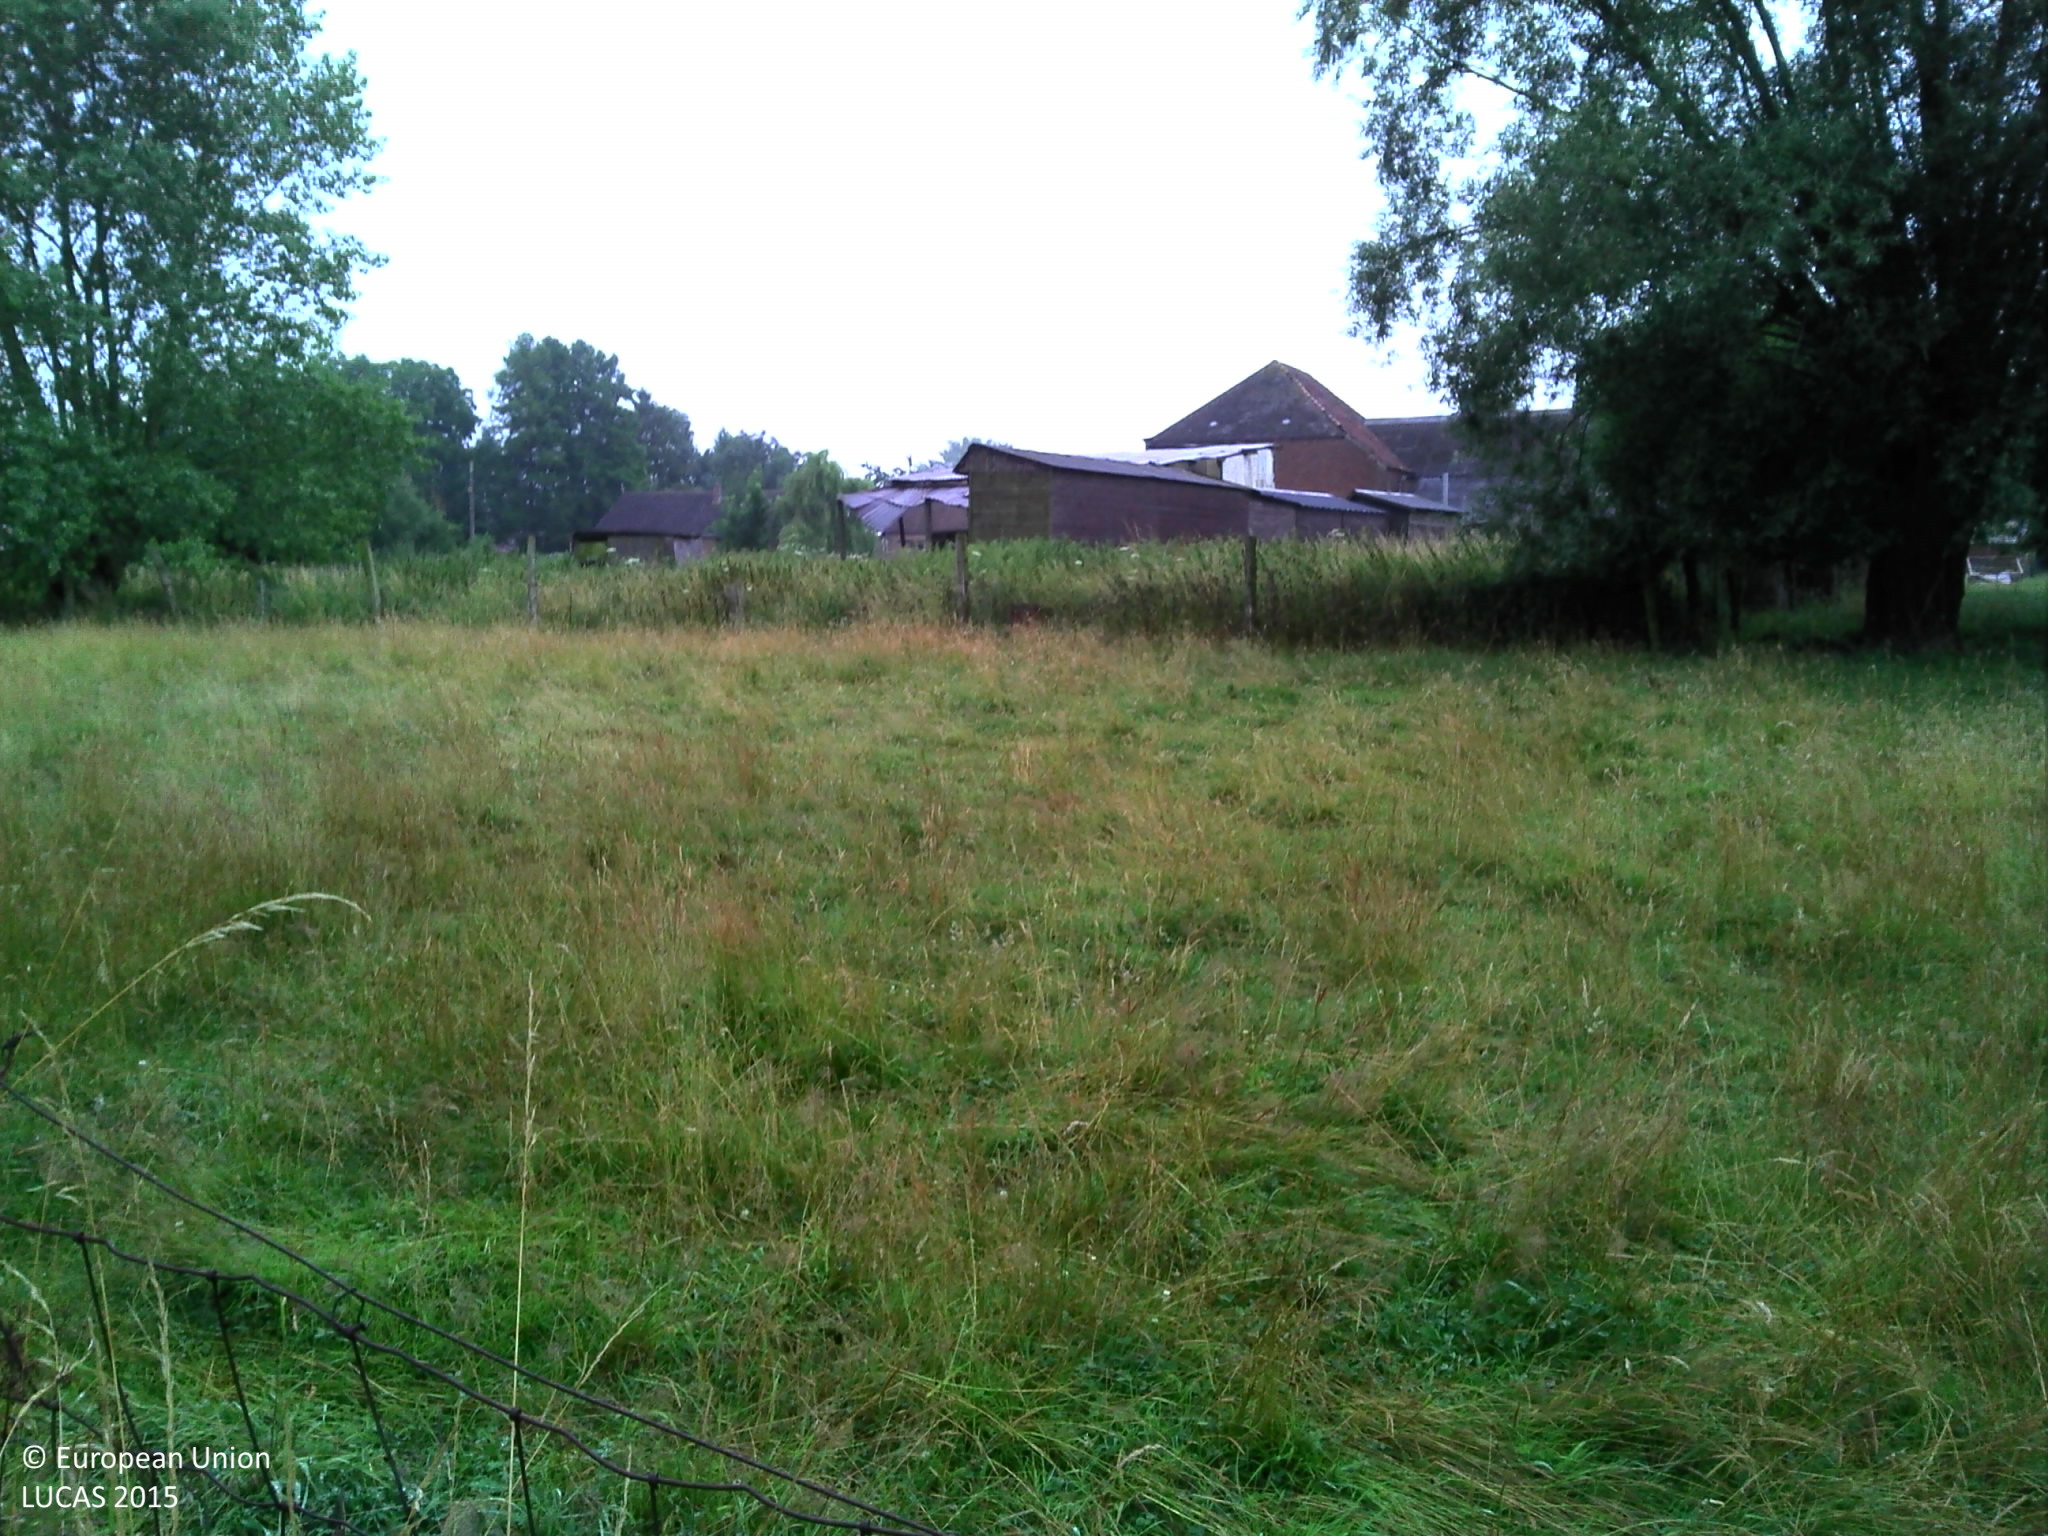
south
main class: Grassland
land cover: Grassland without tree/shrub cover
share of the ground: > 75 %
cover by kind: herbaceous plants 100 %
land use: Agriculture (excluding fallow land and kitchen gardens)
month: July
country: BE
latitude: 50.5848
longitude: 3.9916
